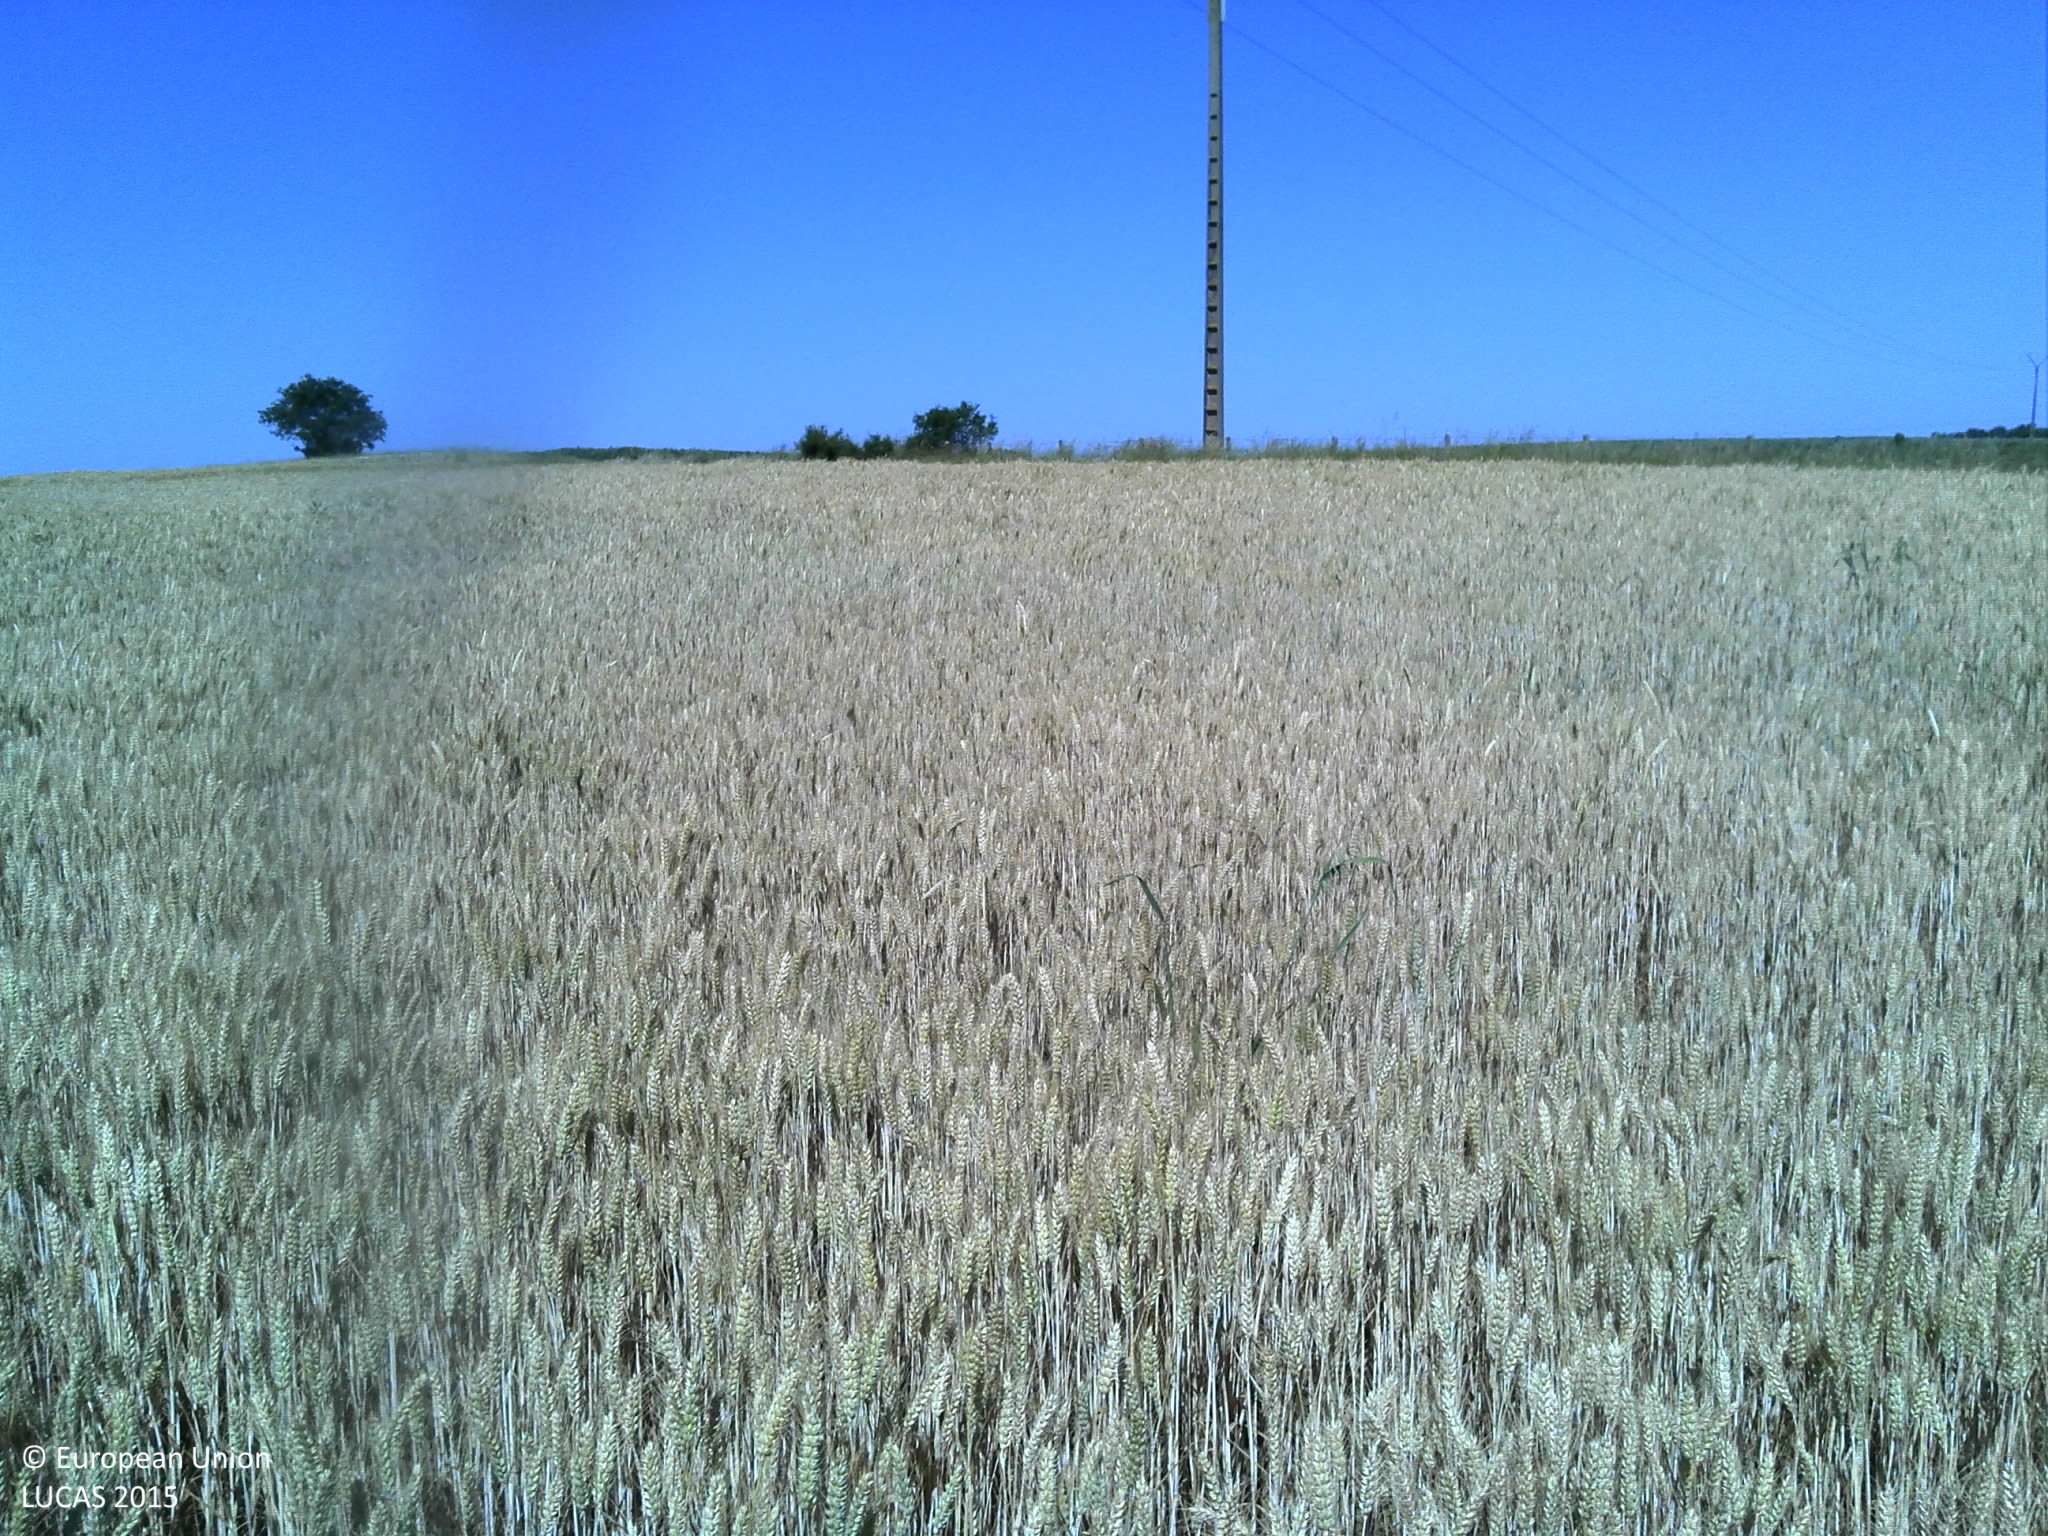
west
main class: Cropland
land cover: Durum wheat
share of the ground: > 75 %
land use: Agriculture (excluding fallow land and kitchen gardens)
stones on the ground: 10 - 25 %
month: June
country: FR
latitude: 49.8420
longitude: 0.9523
